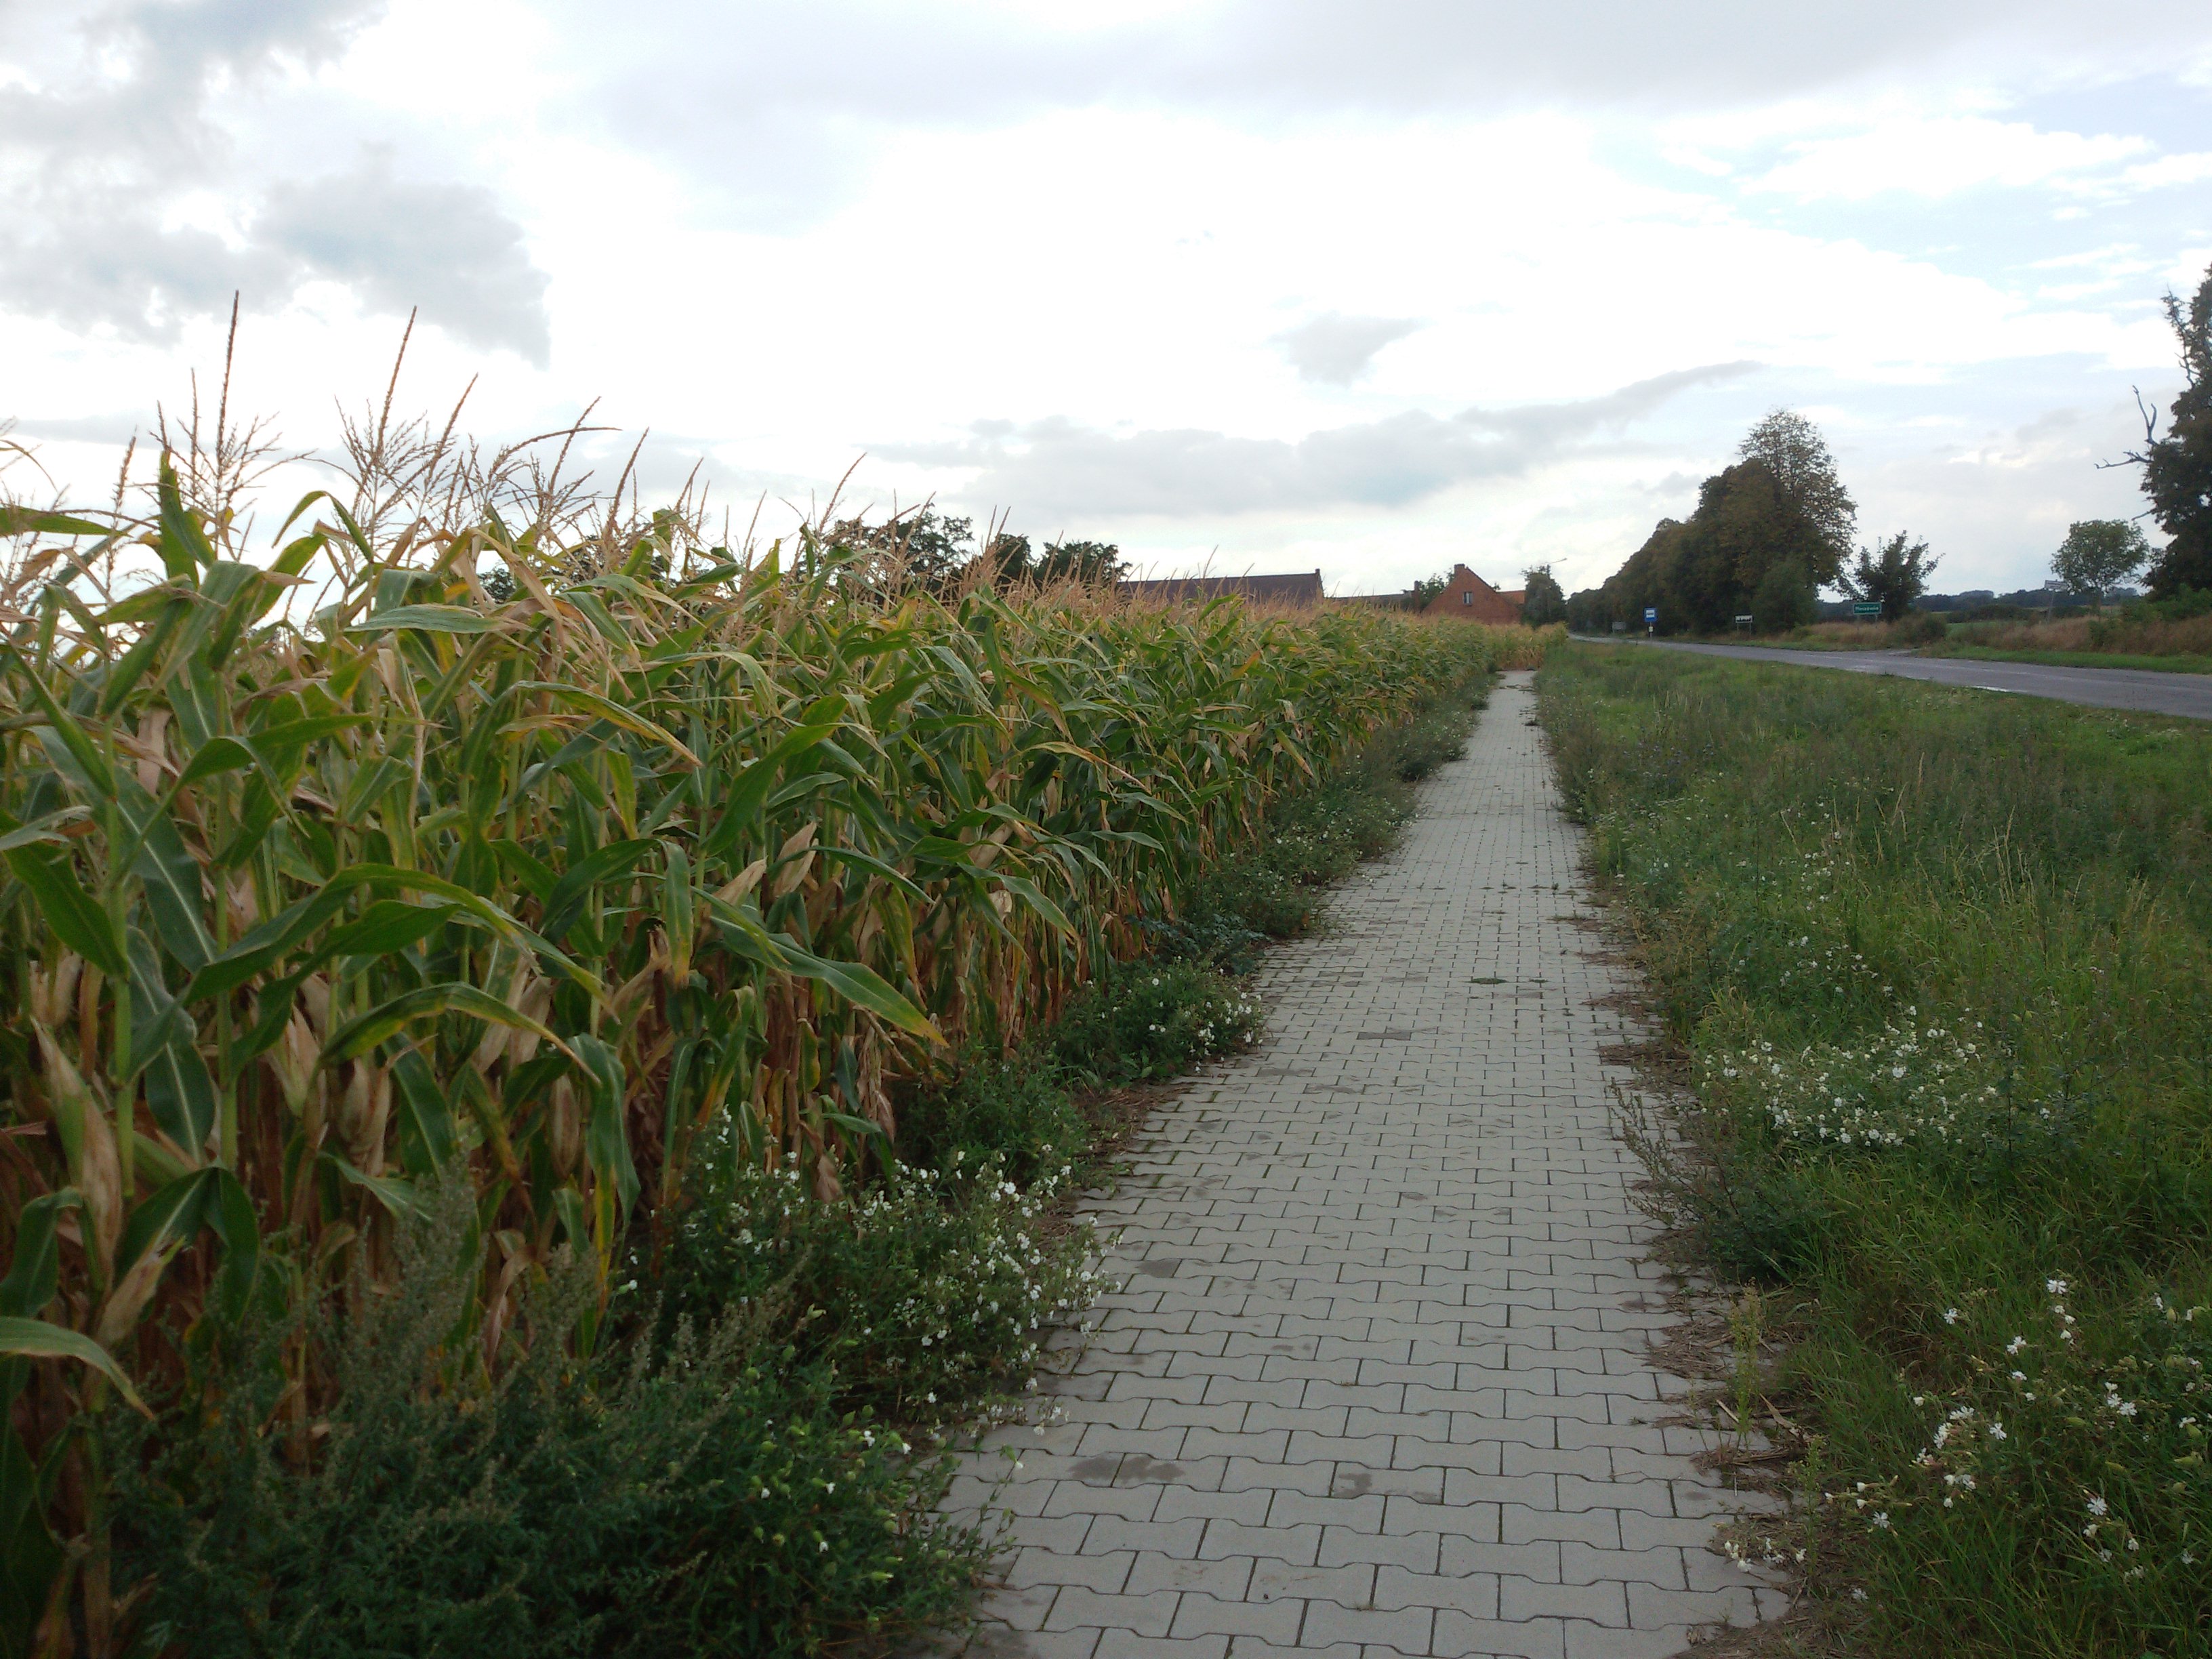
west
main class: Cropland
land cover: Maize
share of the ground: > 75 %
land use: Agriculture (excluding fallow land and kitchen gardens)
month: August
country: PL
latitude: 51.8789
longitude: 17.9031
